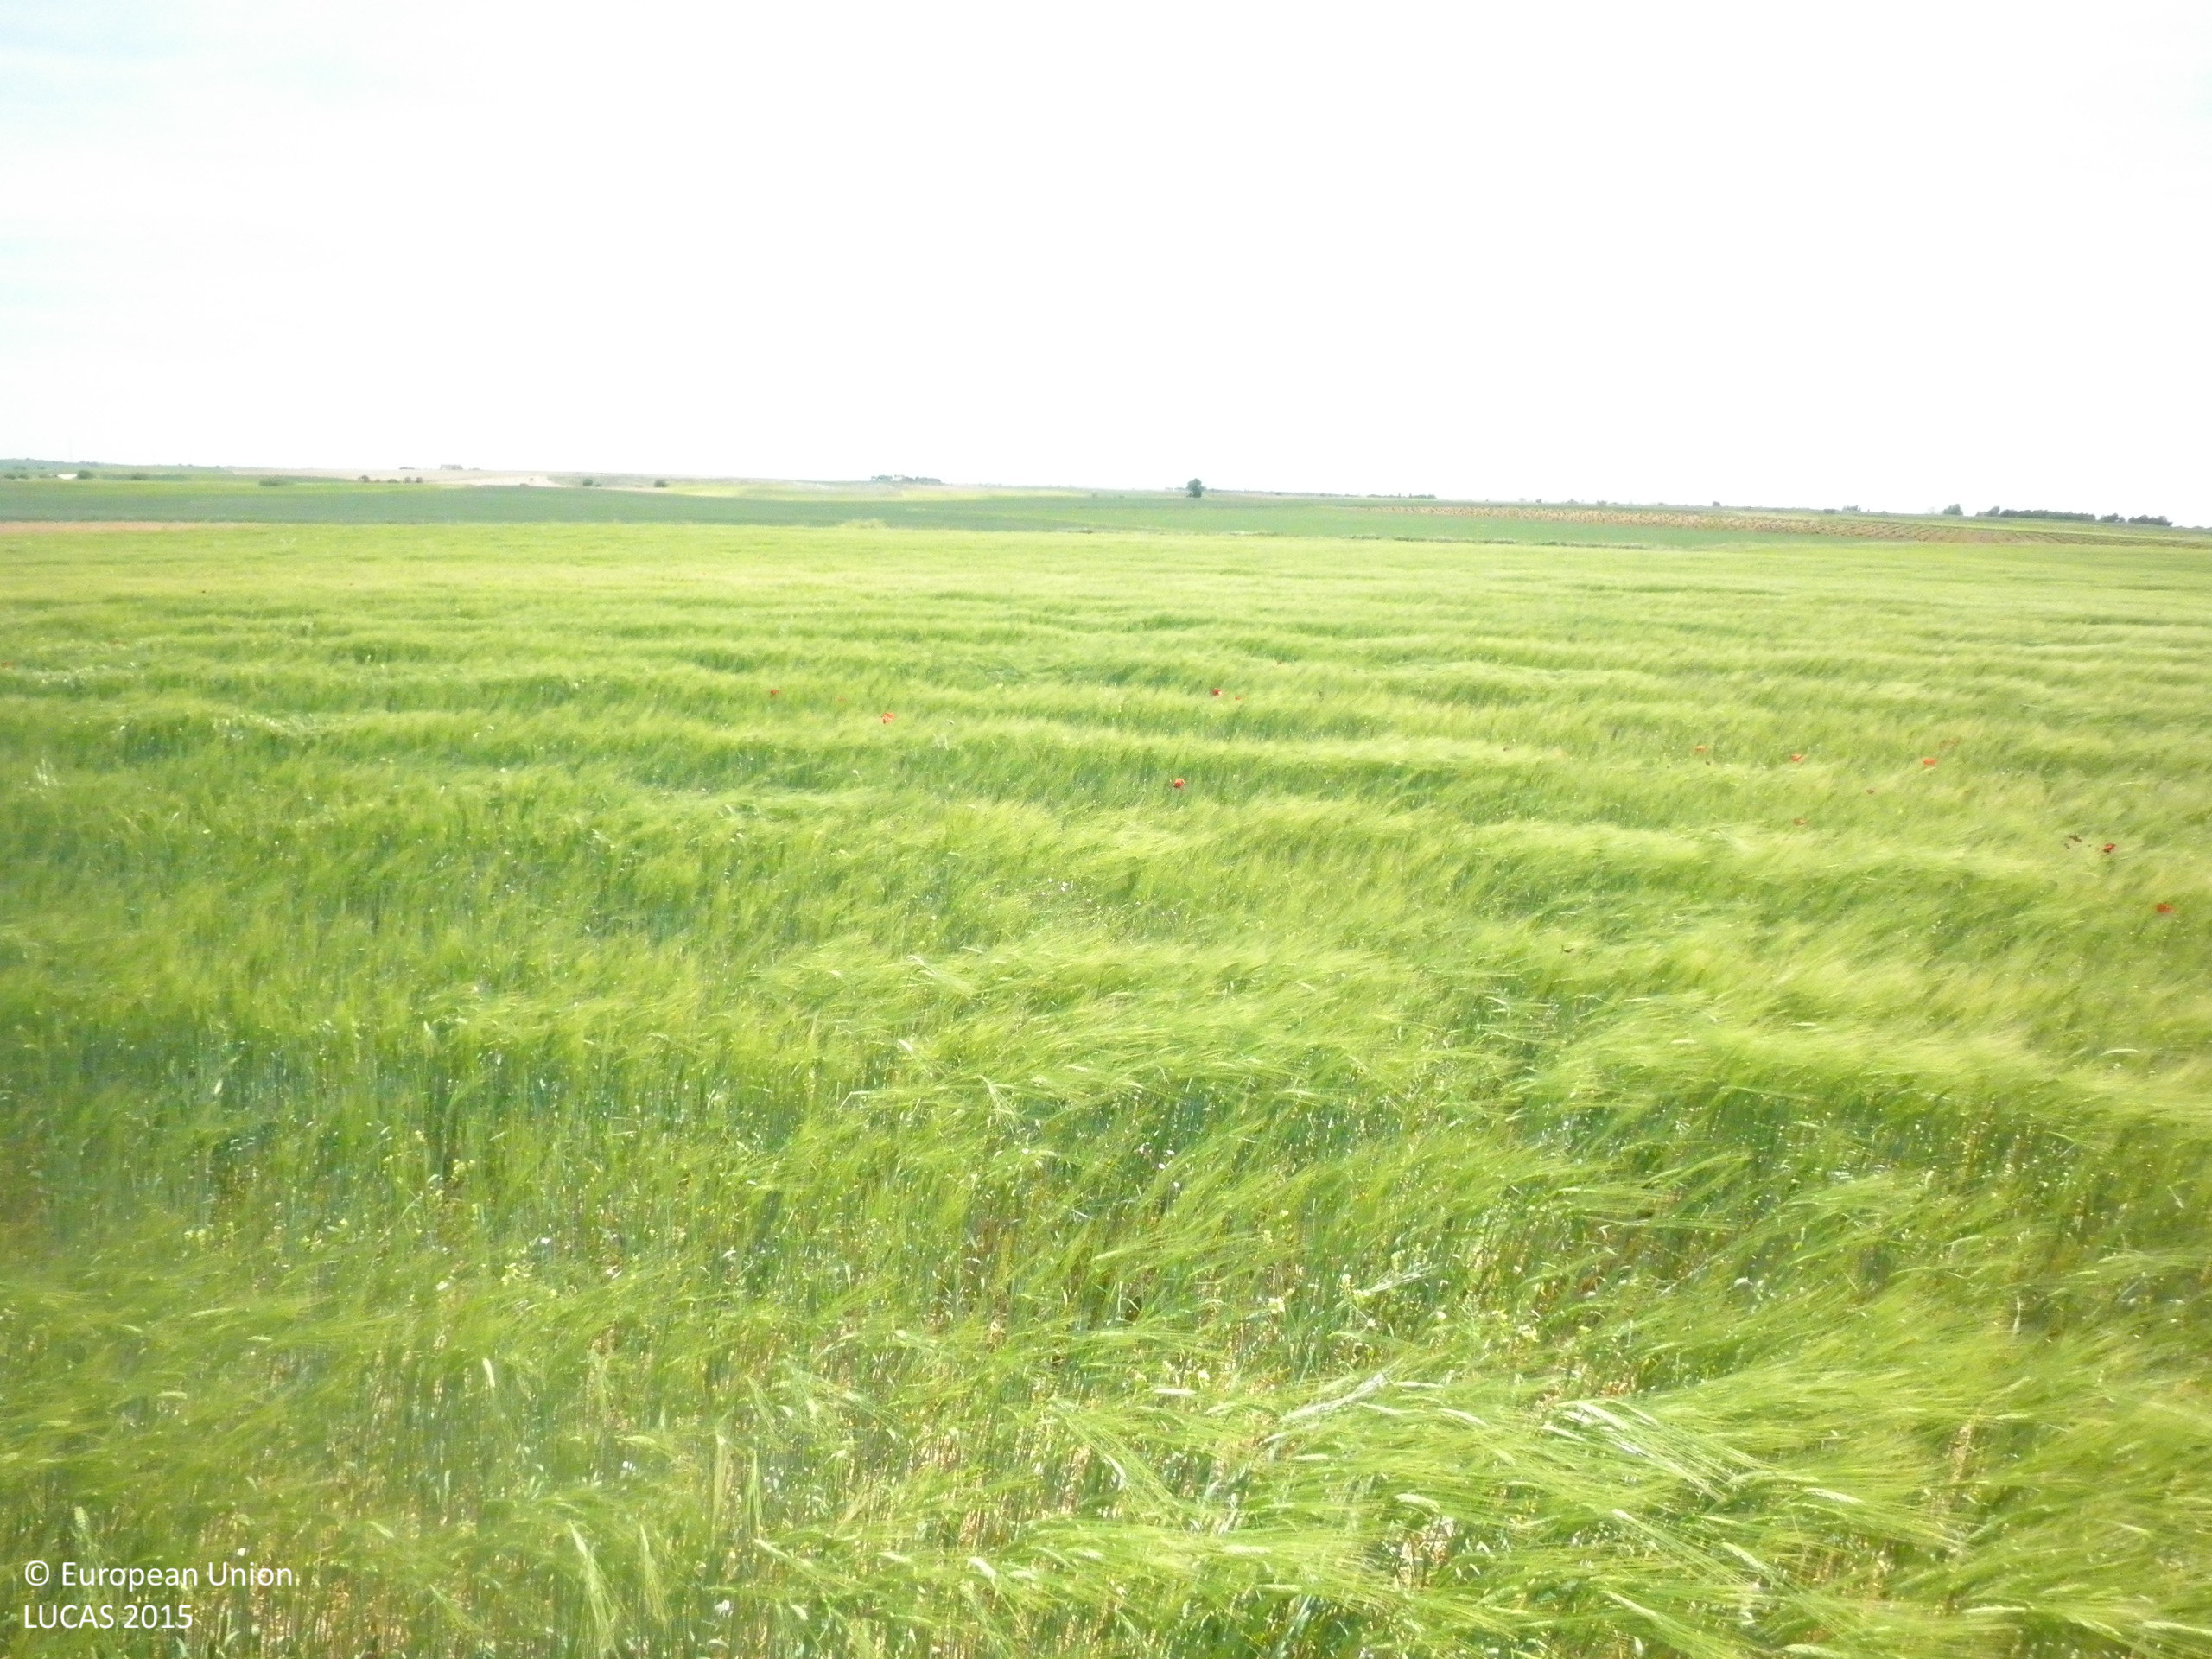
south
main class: Cropland
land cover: Barley
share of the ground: > 75 %
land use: Agriculture (excluding fallow land and kitchen gardens)
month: May
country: ES
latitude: 39.5616
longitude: -2.7368
